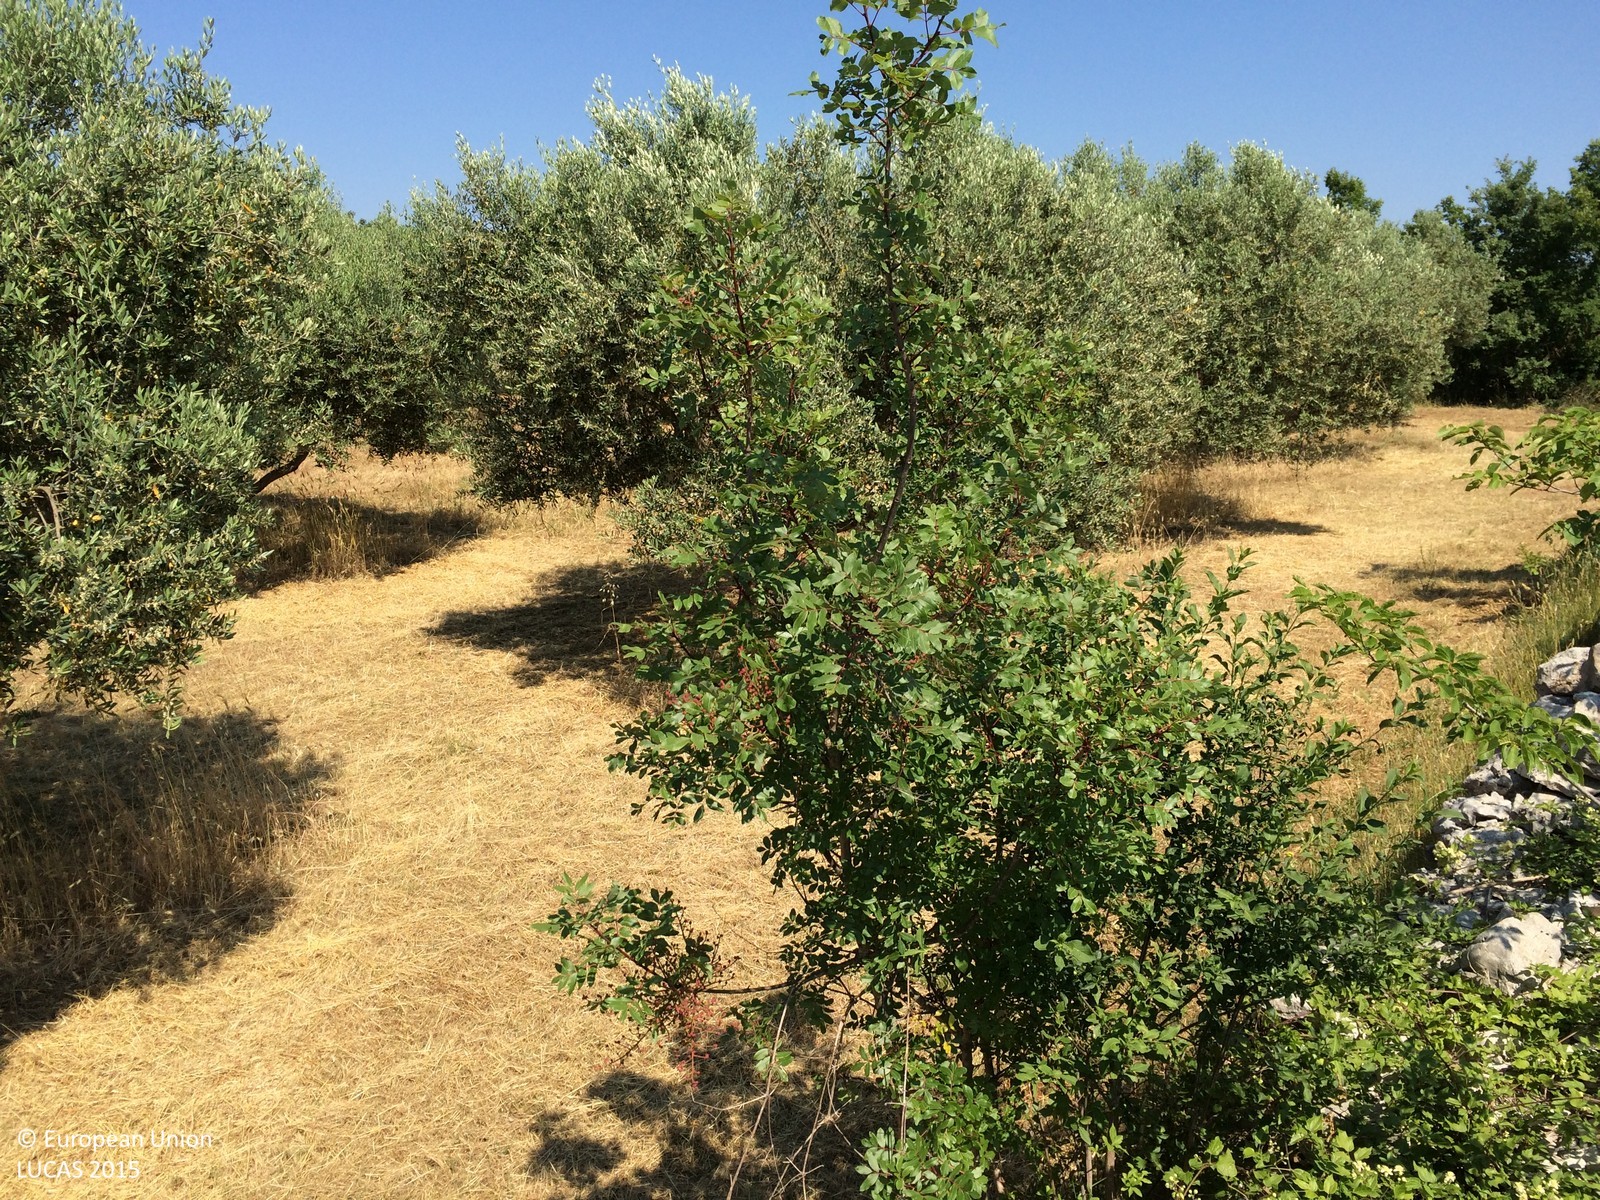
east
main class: Shrubland
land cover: Shrubland with sparse tree cover
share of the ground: > 75 %
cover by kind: shrubs 90 %, broadleaved forest trees 5 %, herbaceous plants 5 %
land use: Semi-natural and natural areas not in use
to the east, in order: Shrubland with sparse tree cover; Dry stone walls; Olive groves; Dry stone walls; Shrubland with sparse tree cover; Grassland with sparse tree/shrub cover; Dry stone walls; Tracks; Grass margins; Dry stone walls; Olive groves; Dry stone walls; Abandoned hedges; Grassland without tree/shrub cover; Abandoned hedges; Dry stone walls; Tracks; Abandoned hedges; Dry stone walls; Abandoned hedges; Grassland with sparse tree/shrub cover; Dry stone walls; Grassland without tree/shrub cover; Managed hedges; Dry stone walls; Grassland without tree/shrub cover
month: June
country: HR
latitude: 44.9836
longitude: 13.8370
